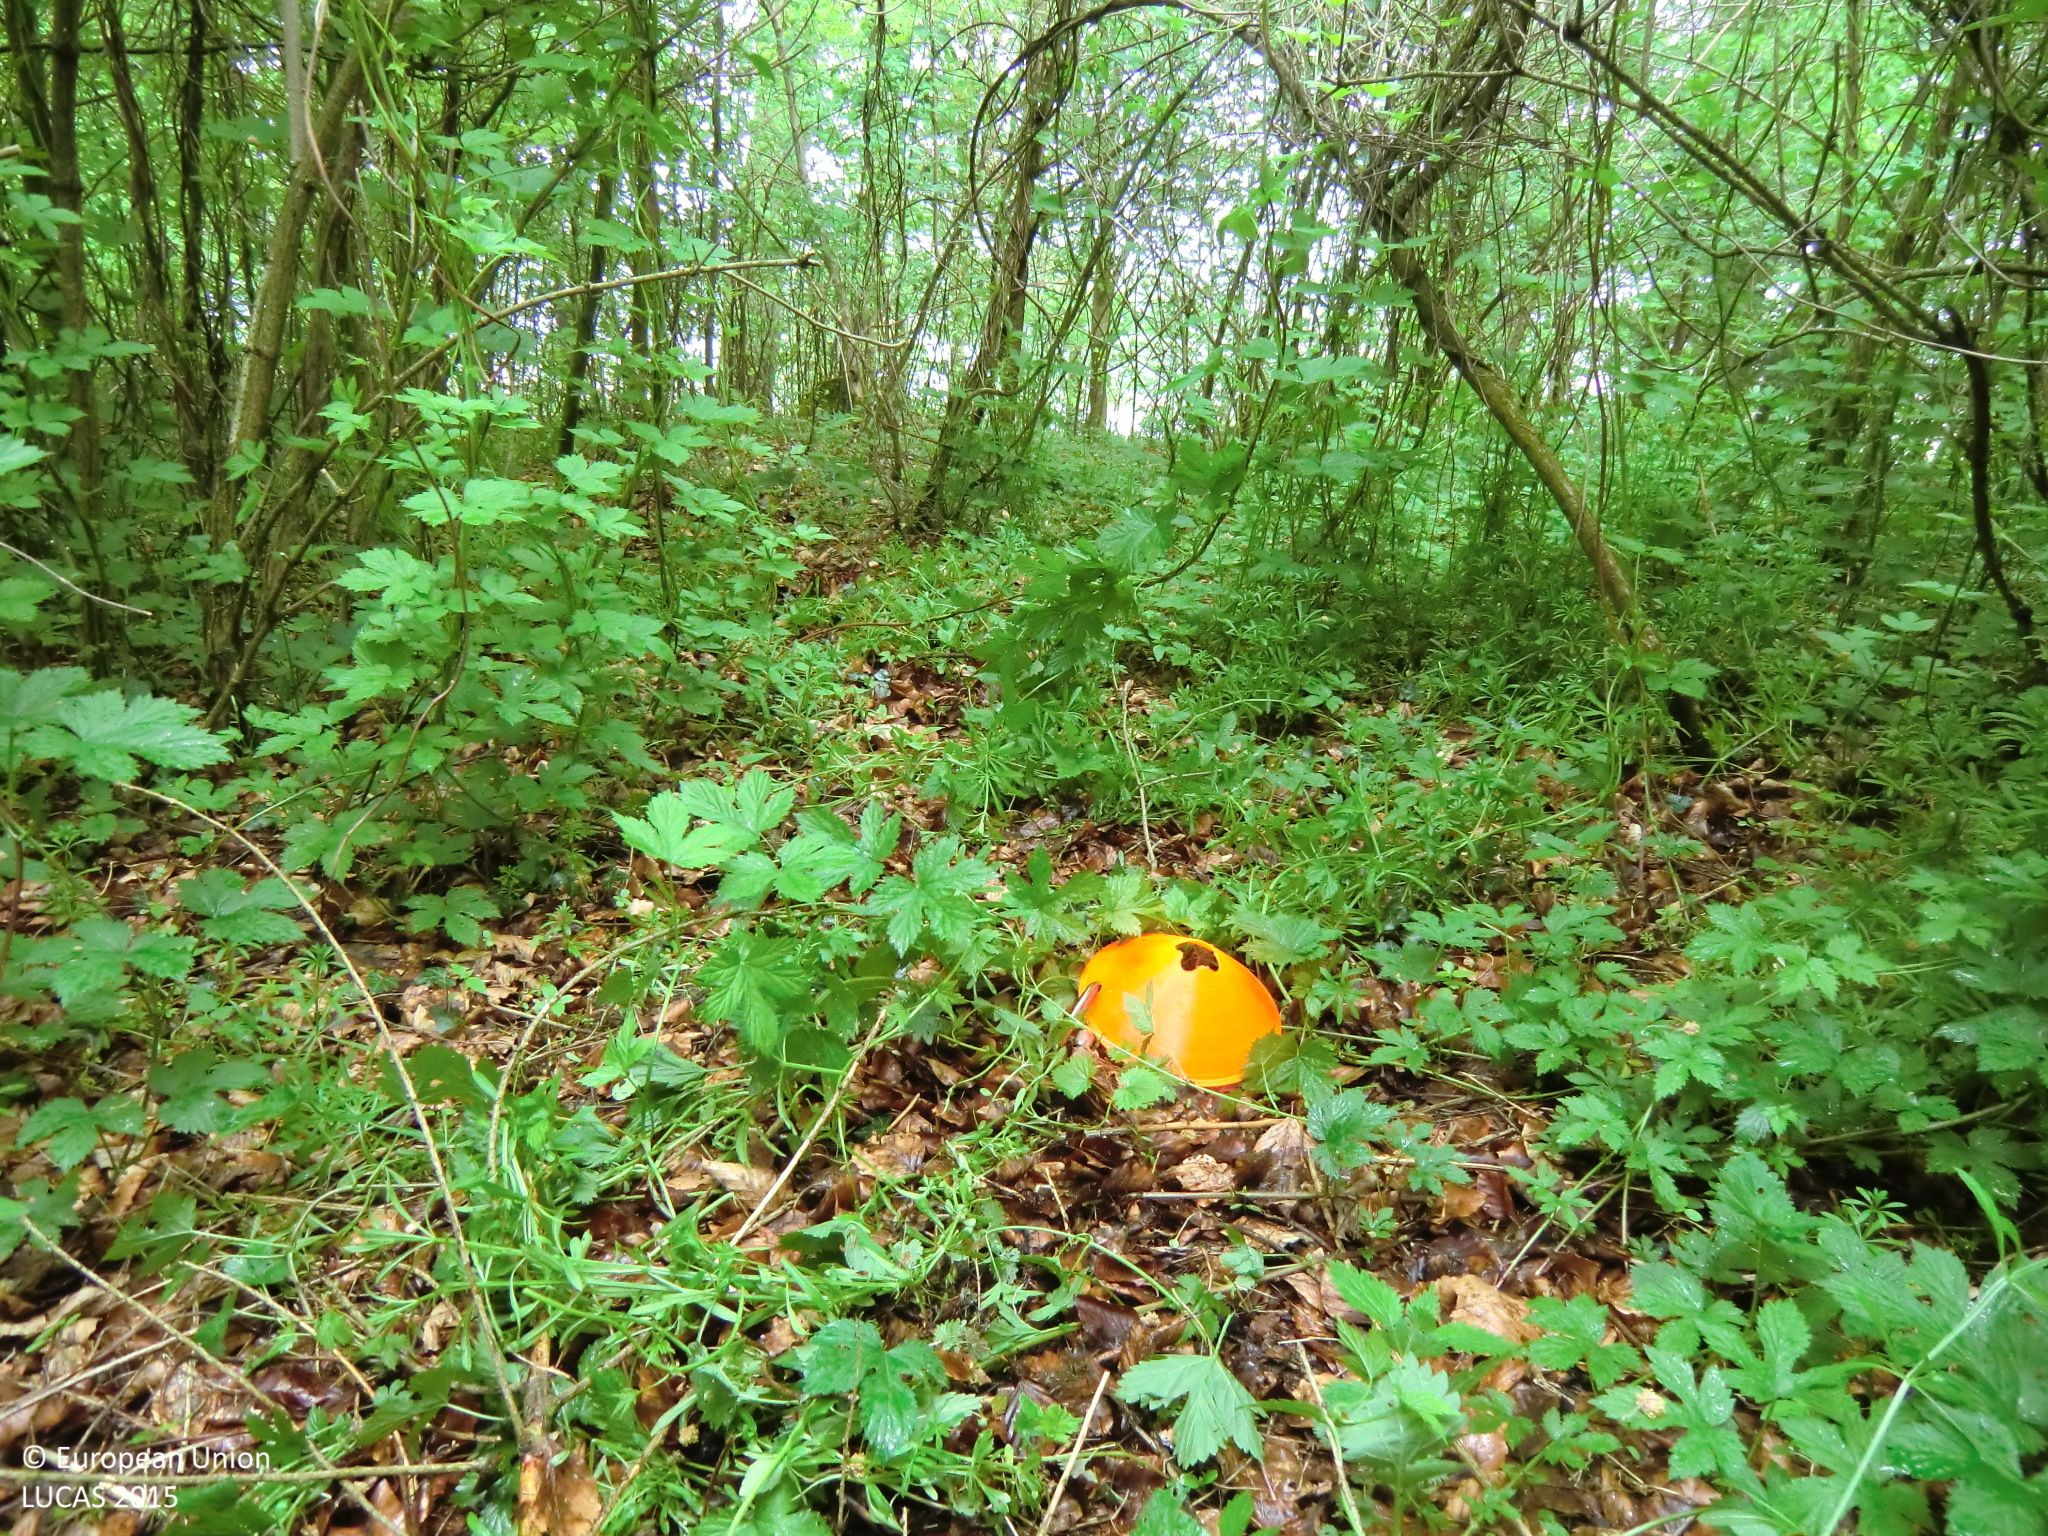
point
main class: Woodland
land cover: Other mixed woodland
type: mountainous beech forest
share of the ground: > 75 %
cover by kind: broadleaved forest trees 55 %, coniferous forest trees 30 %, shrubs 10 %, herbaceous plants 5 %
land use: Forestry
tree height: > 5 m
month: May
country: AT
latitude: 48.2113
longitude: 14.7512
